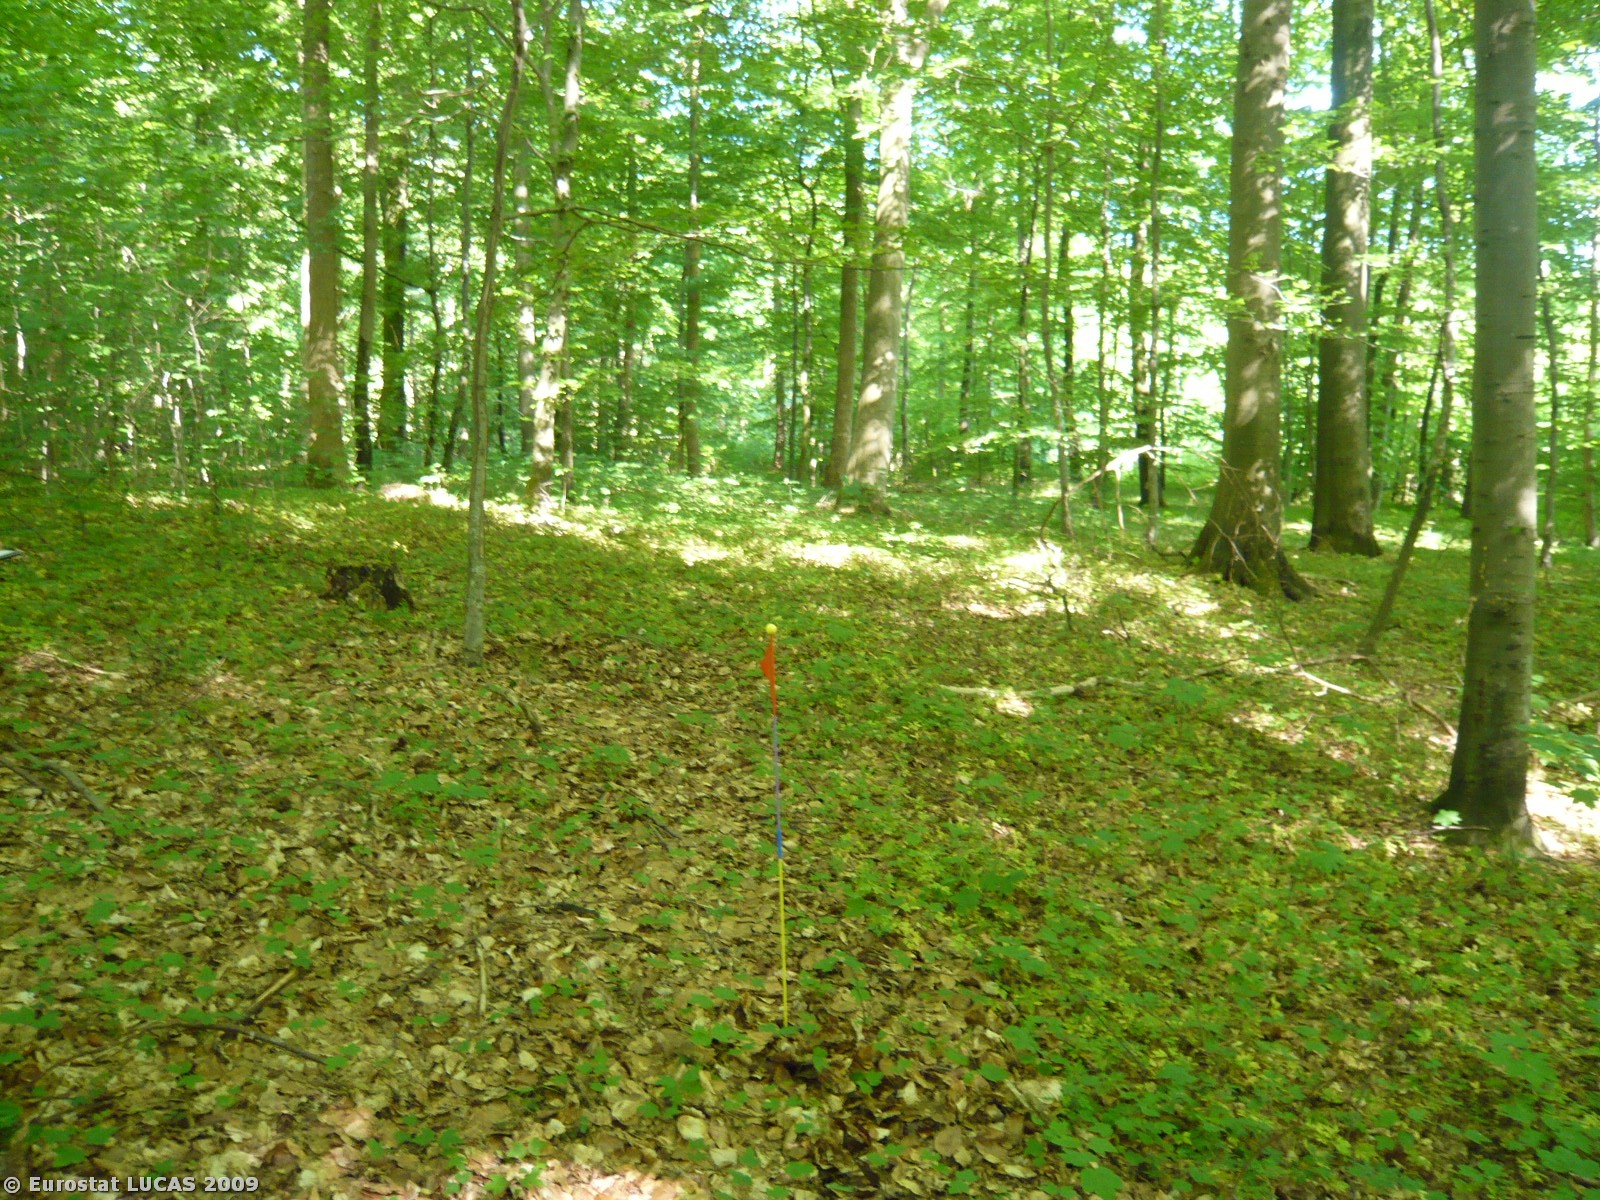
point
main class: Woodland
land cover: Broadleaved woodland
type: mesophytic deciduous forest
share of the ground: > 75 %
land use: Forestry
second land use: Amenities, museums, leisure
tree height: > 5 m
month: May
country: DK
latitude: 55.2765
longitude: 11.7774
